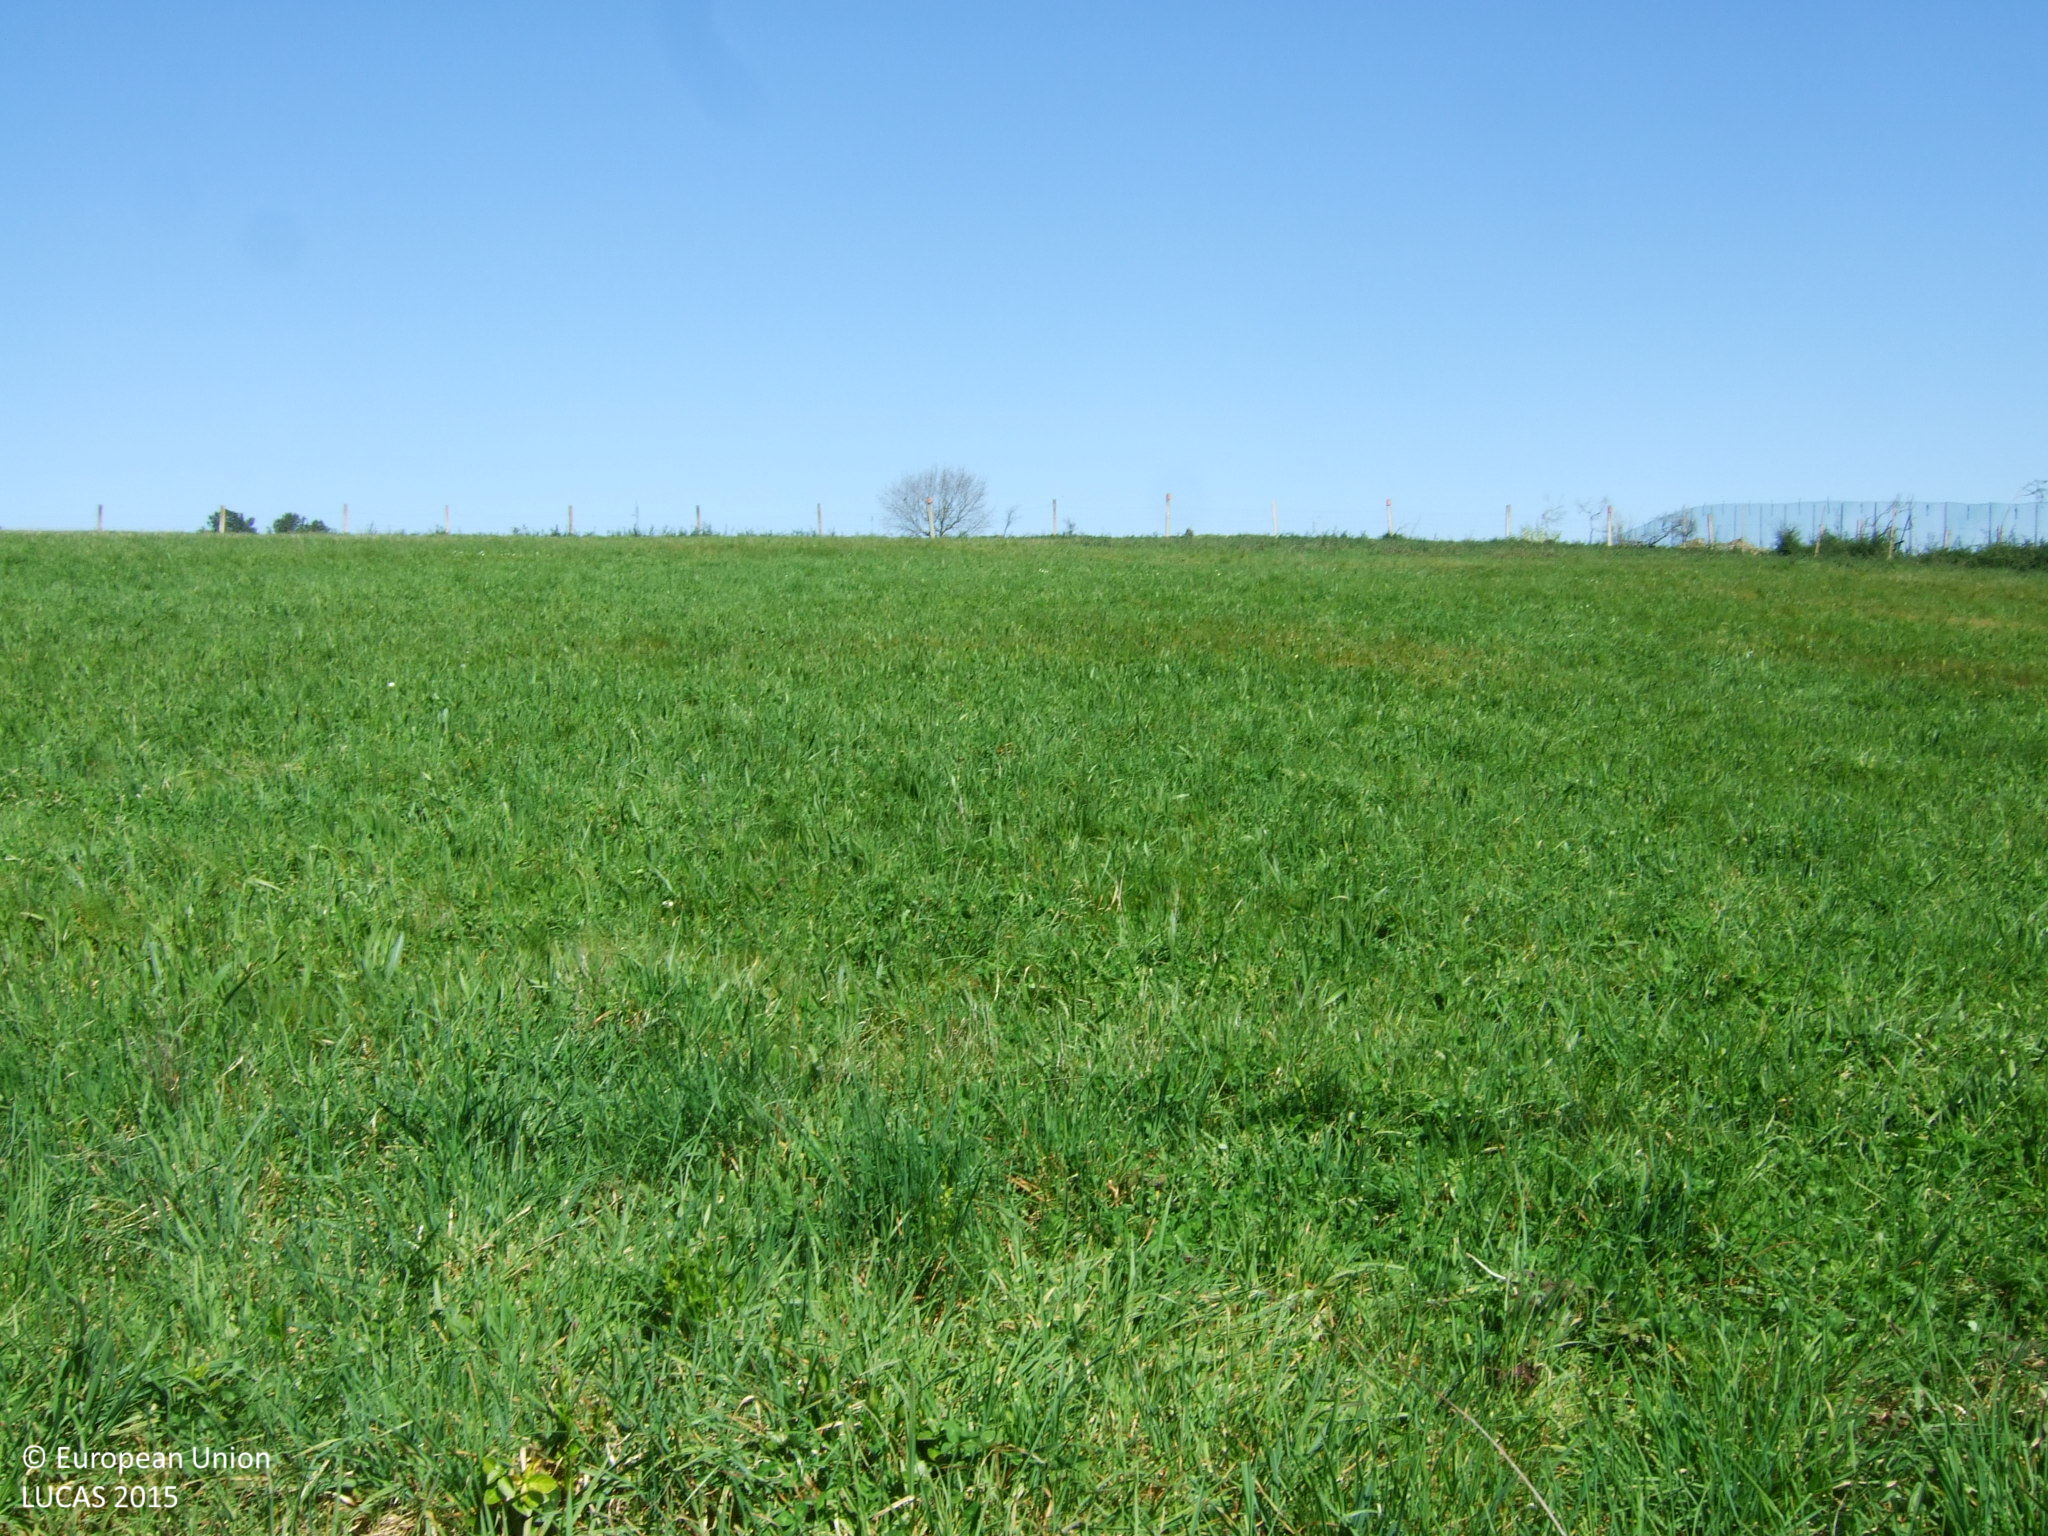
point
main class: Grassland
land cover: Grassland without tree/shrub cover
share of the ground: > 75 %
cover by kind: herbaceous plants 100 %
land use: Agriculture (excluding fallow land and kitchen gardens)
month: April
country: ES
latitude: 42.6960
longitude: -7.7415
